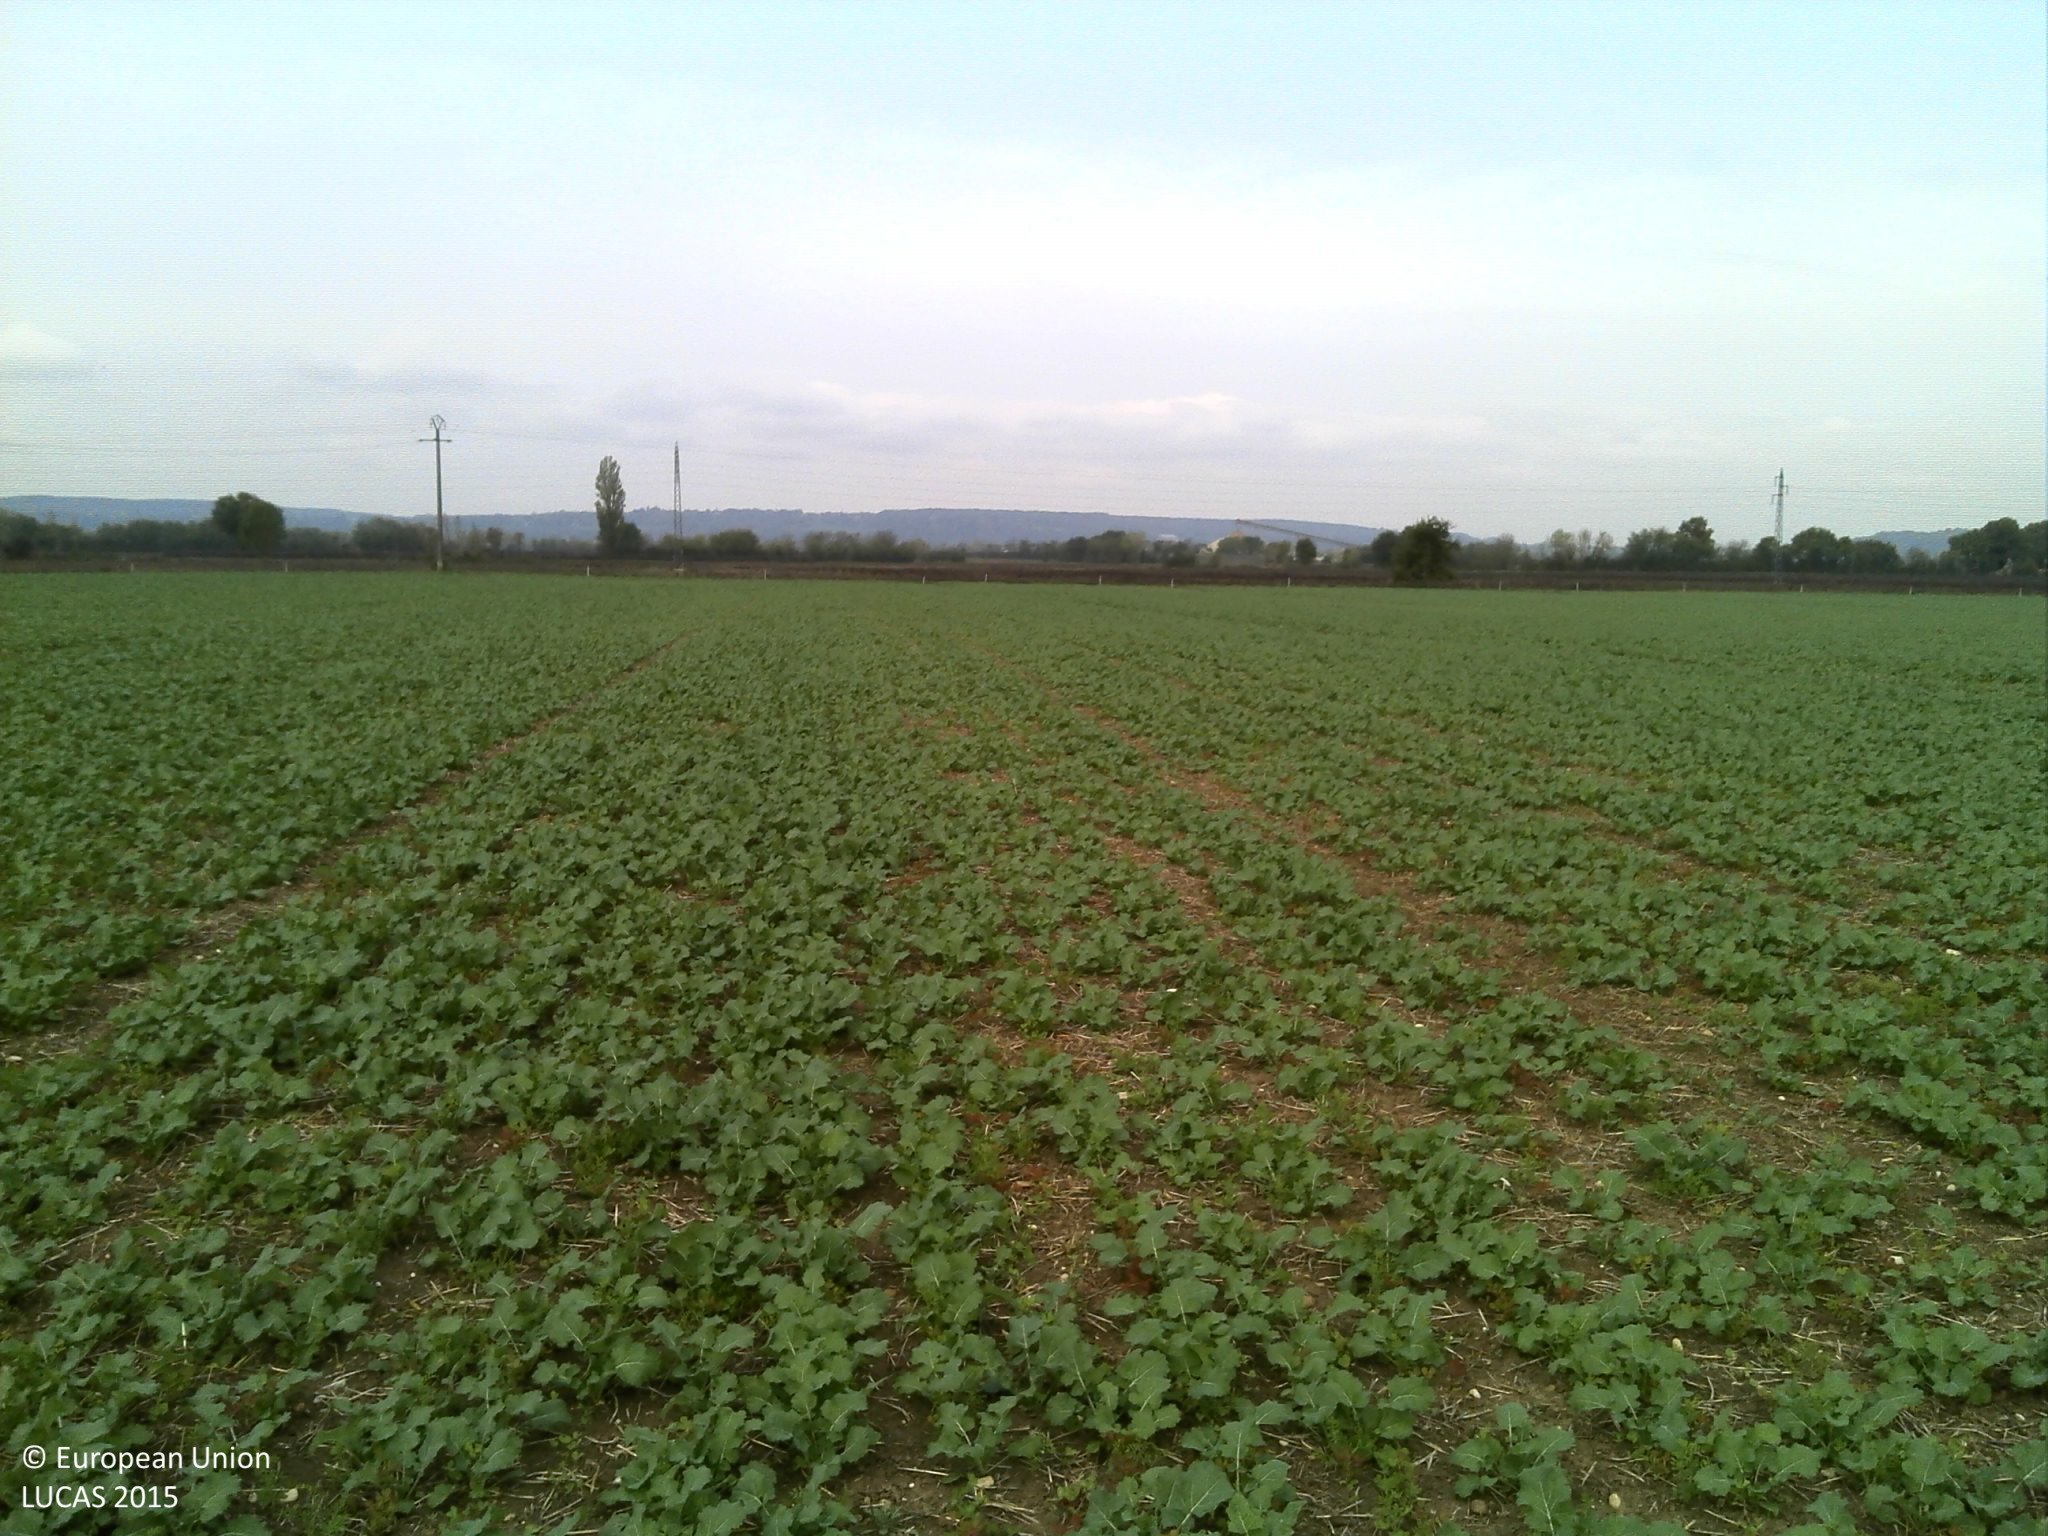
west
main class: Cropland
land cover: Rape and turnip rape
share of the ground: 50 - 75 %
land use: Agriculture (excluding fallow land and kitchen gardens)
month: October
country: FR
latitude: 46.0163
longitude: 5.3666
